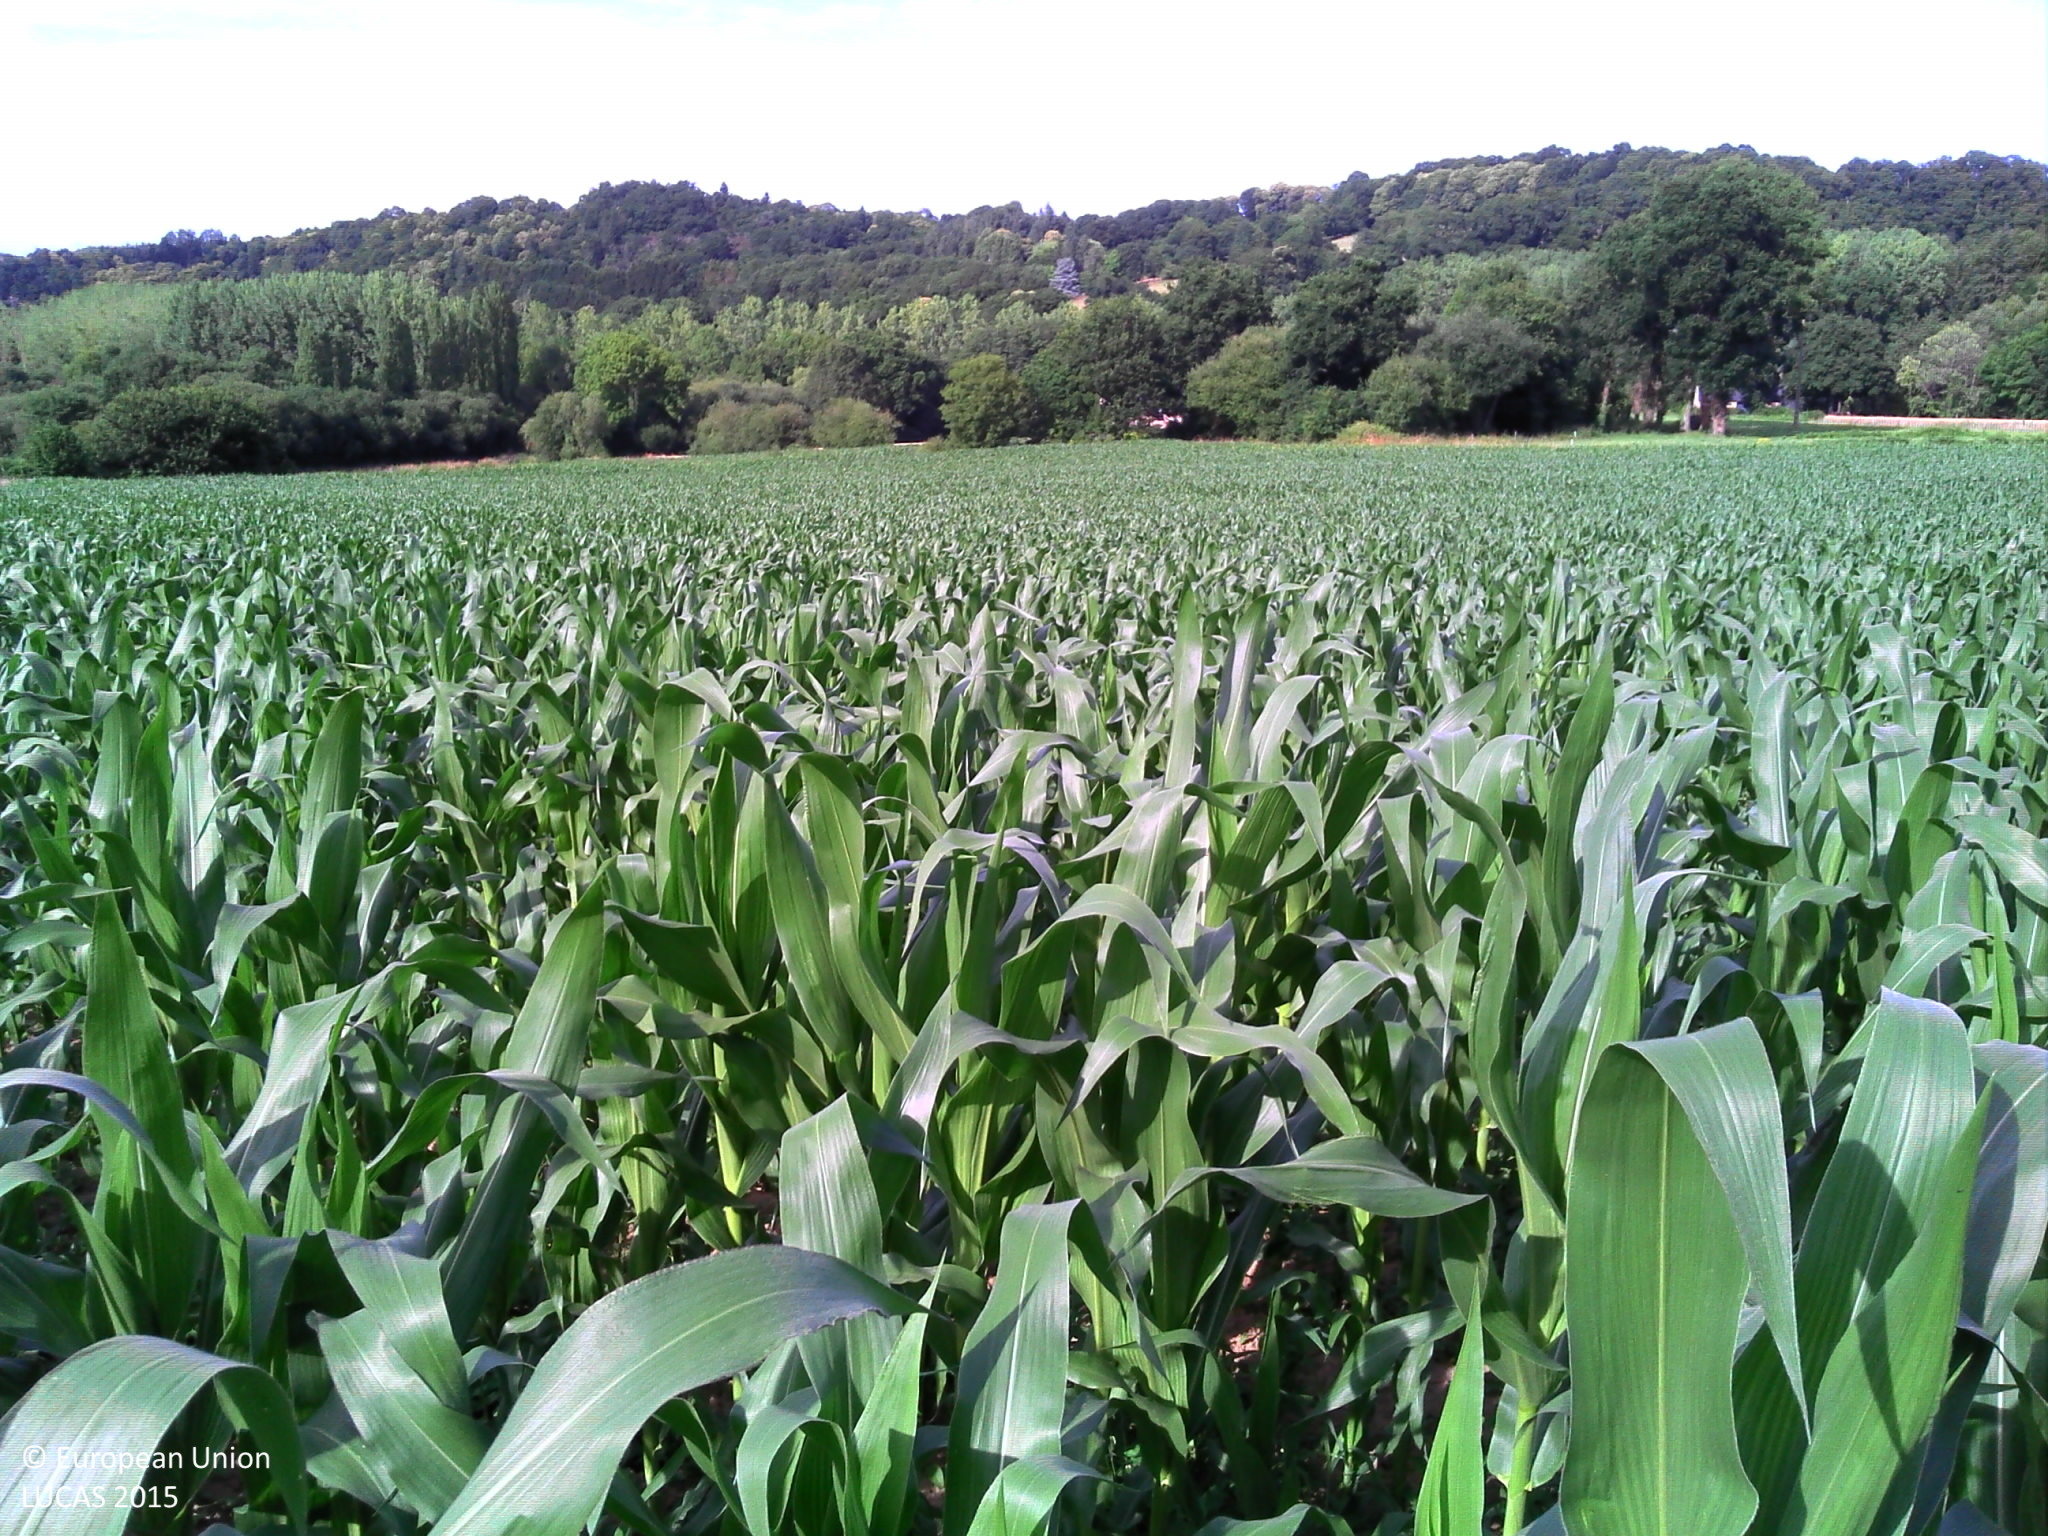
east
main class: Cropland
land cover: Maize
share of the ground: > 75 %
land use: Agriculture (excluding fallow land and kitchen gardens)
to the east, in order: Maize; Grass margins; Ditches and canals; Artificial constructions in urban areas; Common wheat; Tracks; Abandoned hedges; Fences; Spontaneously vegetated surfaces; Rivers and streams; Broadleaved woodland
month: July
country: FR
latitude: 48.4337
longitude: -2.0432
